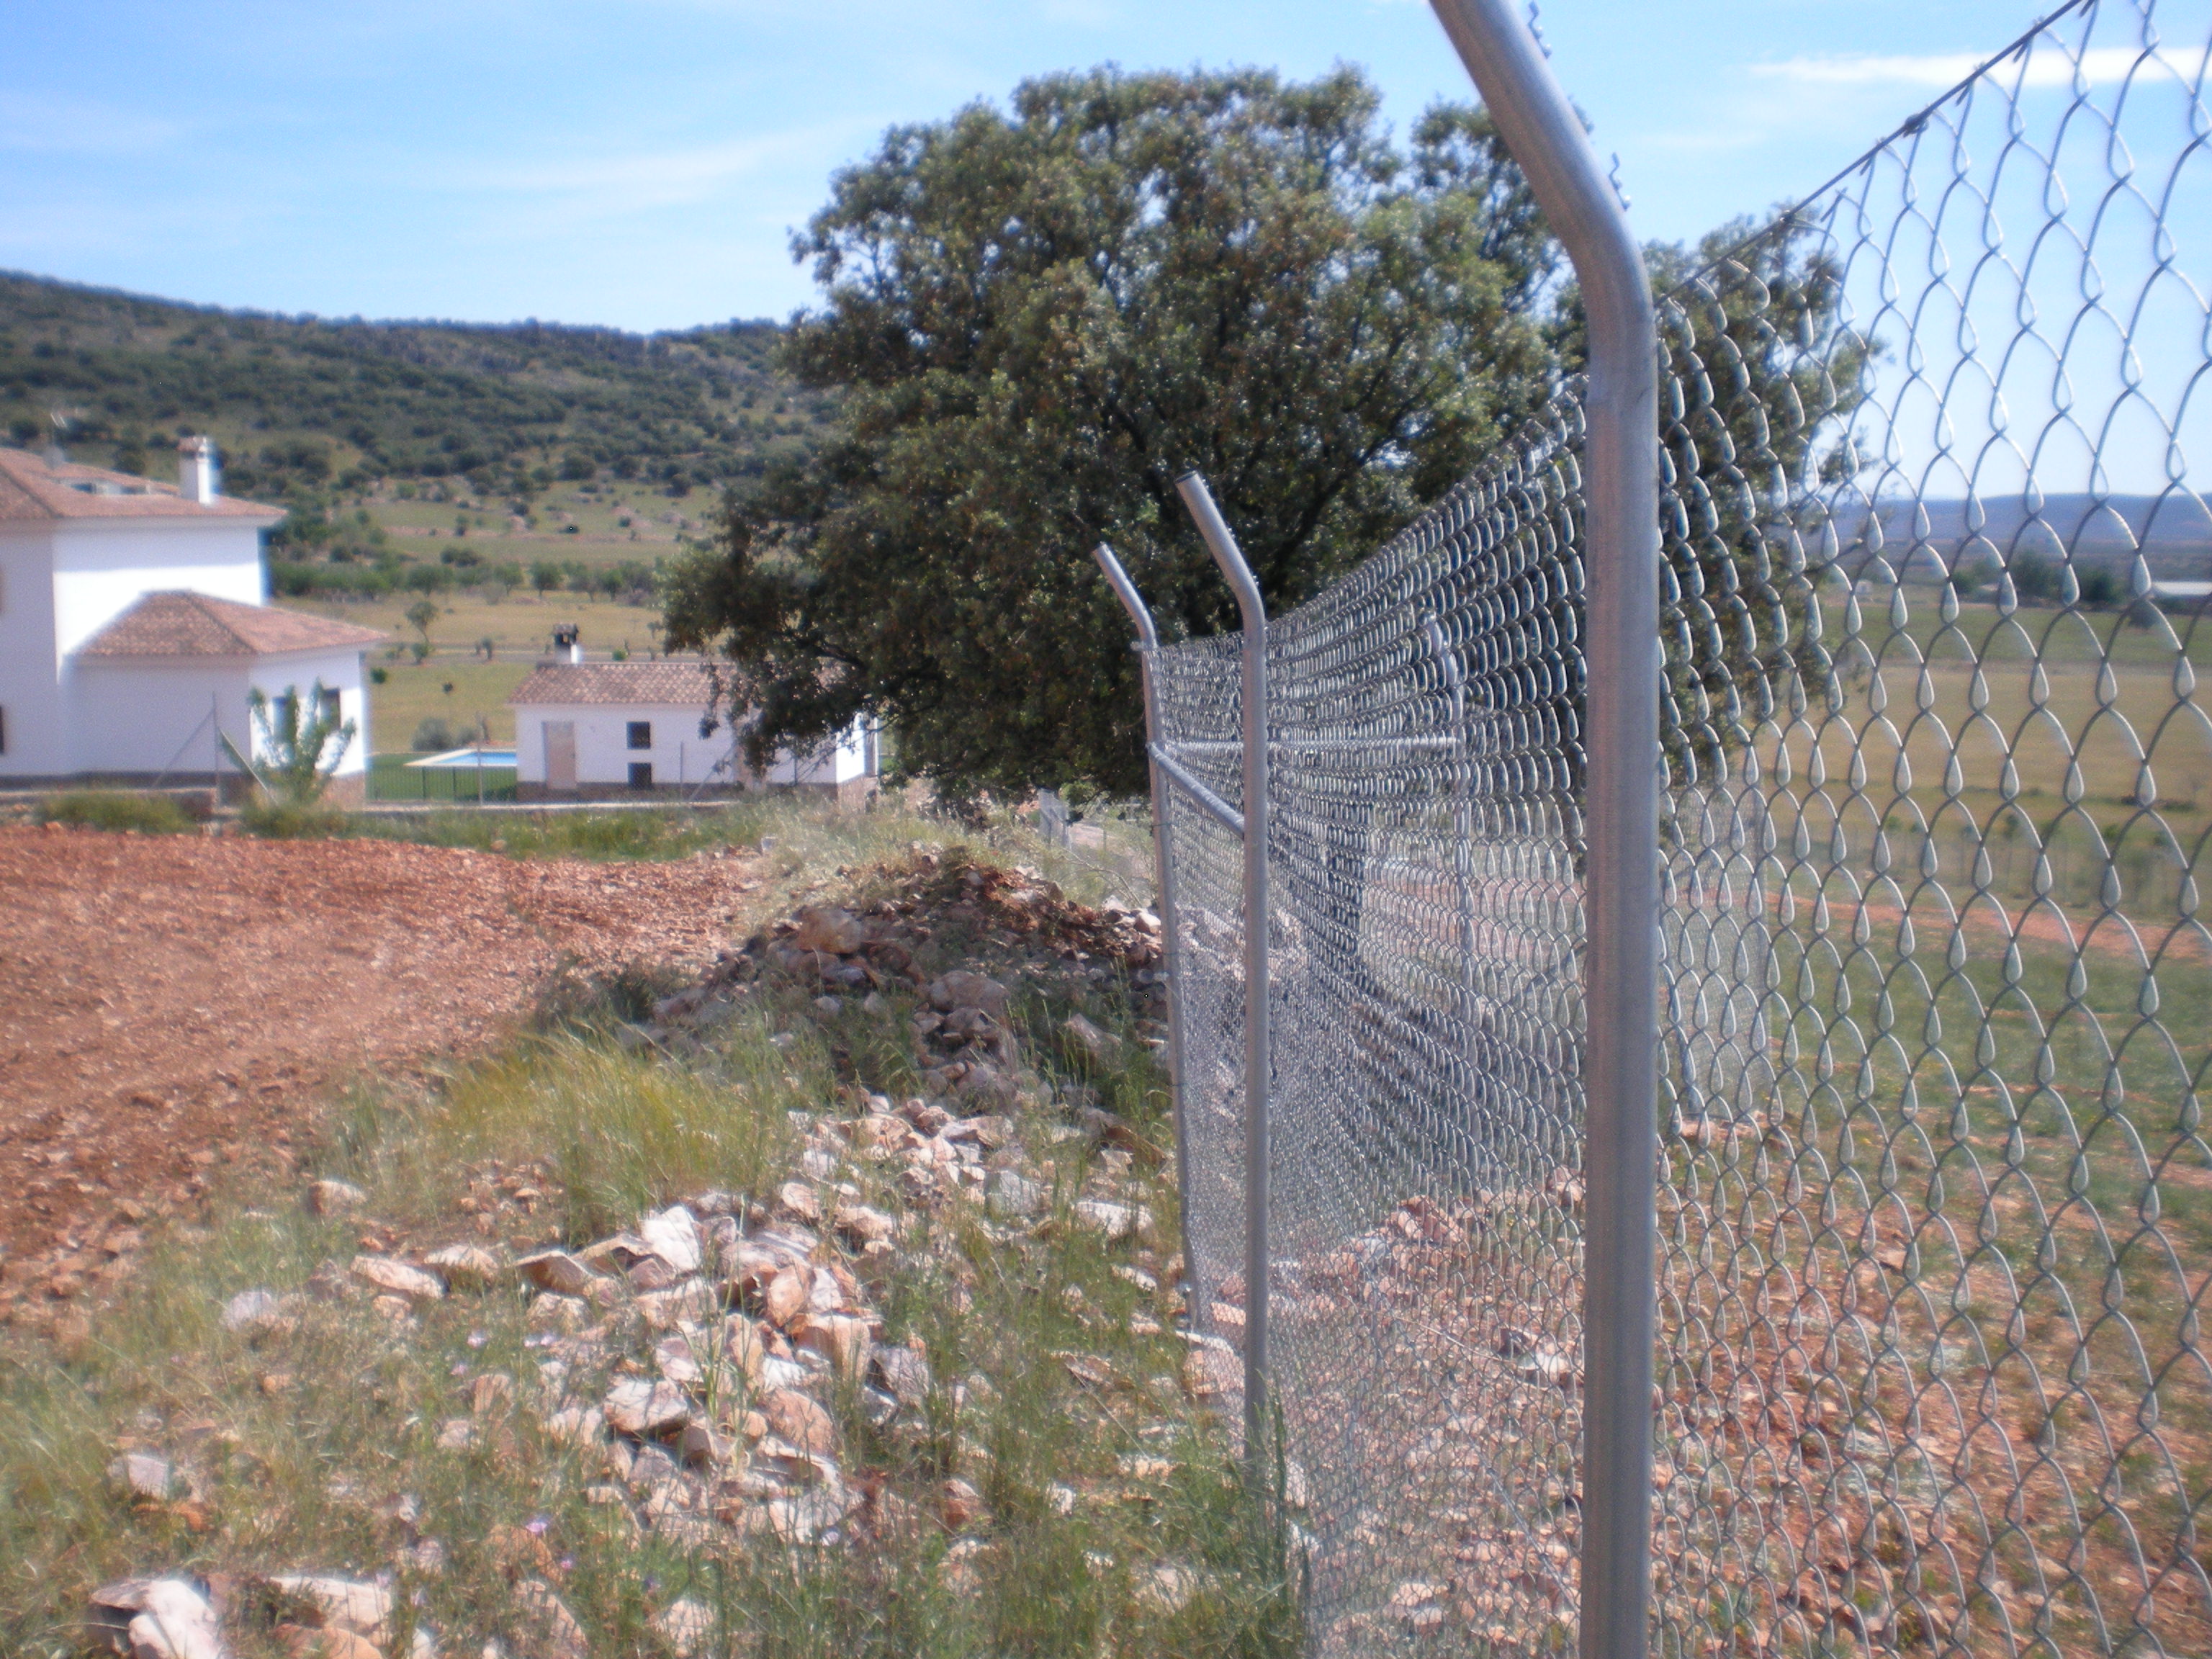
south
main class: Cropland
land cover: Olive groves
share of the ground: < 10 %
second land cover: Spontaneously vegetated surfaces
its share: 10 - 25 %
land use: Agriculture (excluding fallow land and kitchen gardens)
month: May
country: ES
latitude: 38.8279
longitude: -3.5484
